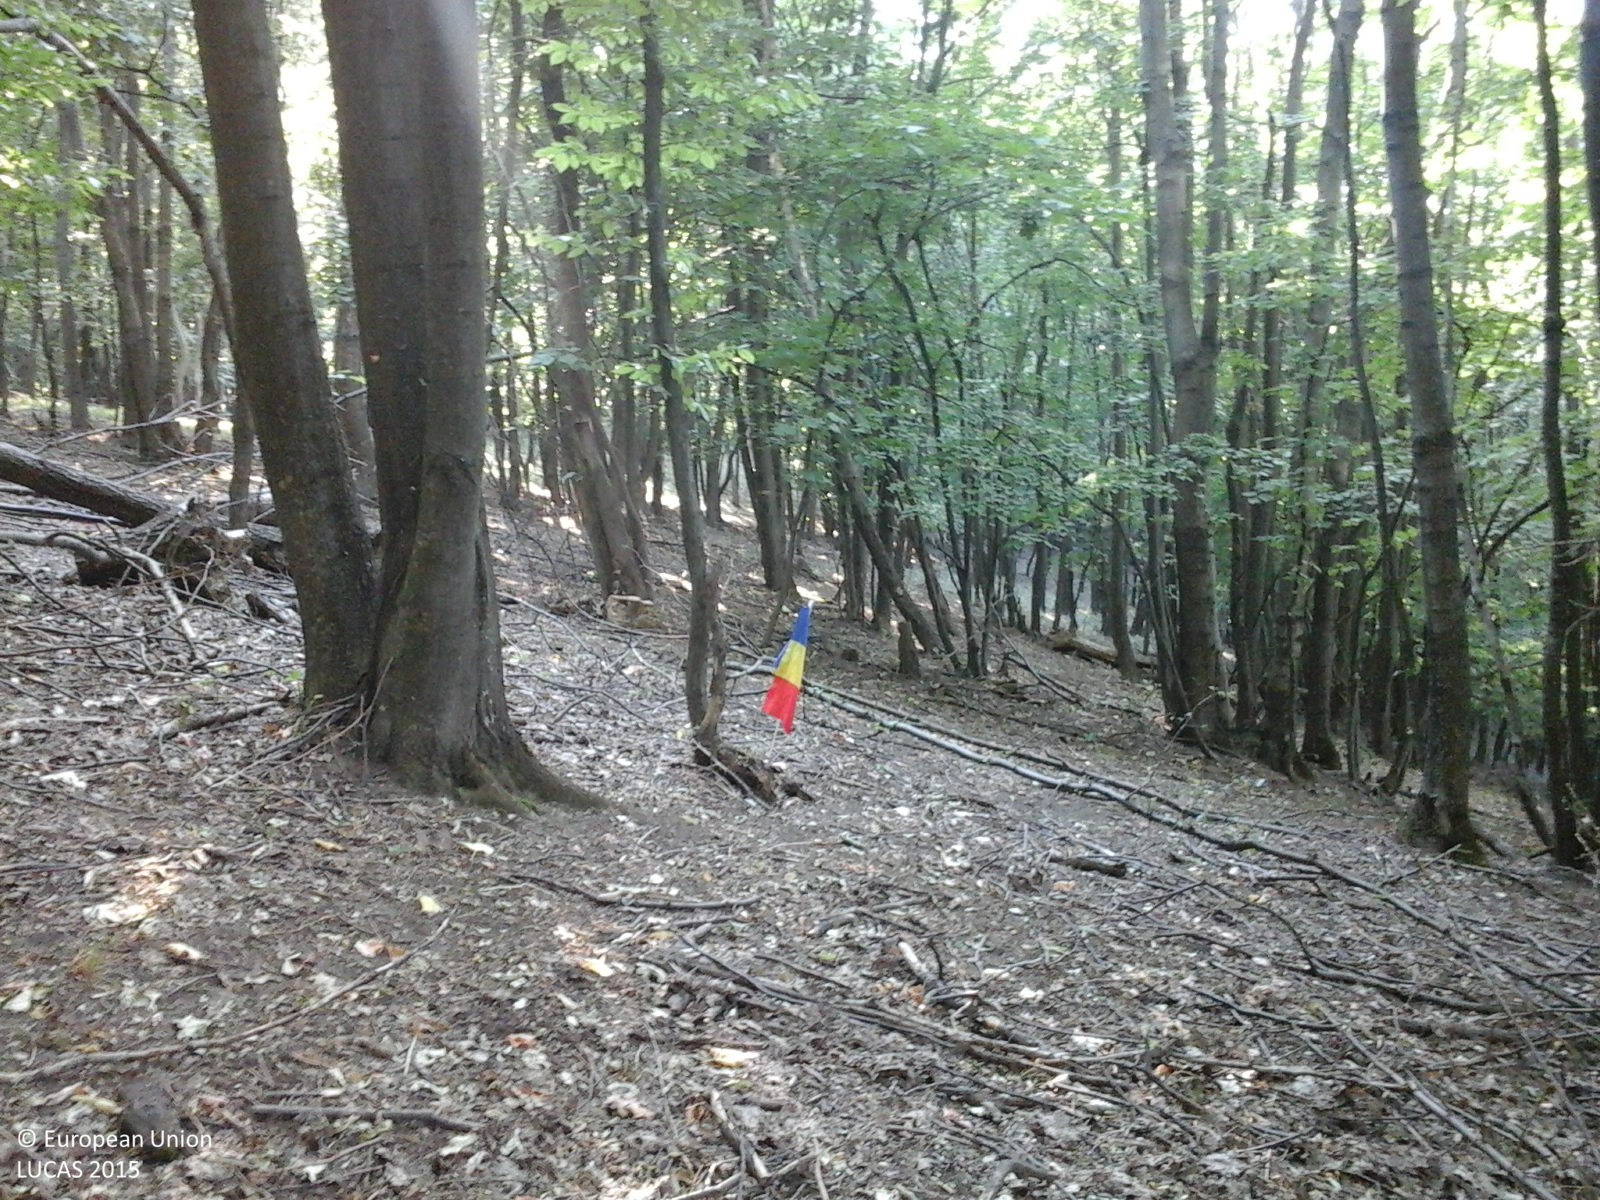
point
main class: Woodland
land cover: Broadleaved woodland
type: mesophytic deciduous forest
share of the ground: > 75 %
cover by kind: broadleaved forest trees 100 %
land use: Forestry
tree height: > 5 m
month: June
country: RO
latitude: 46.9445
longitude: 27.9020
